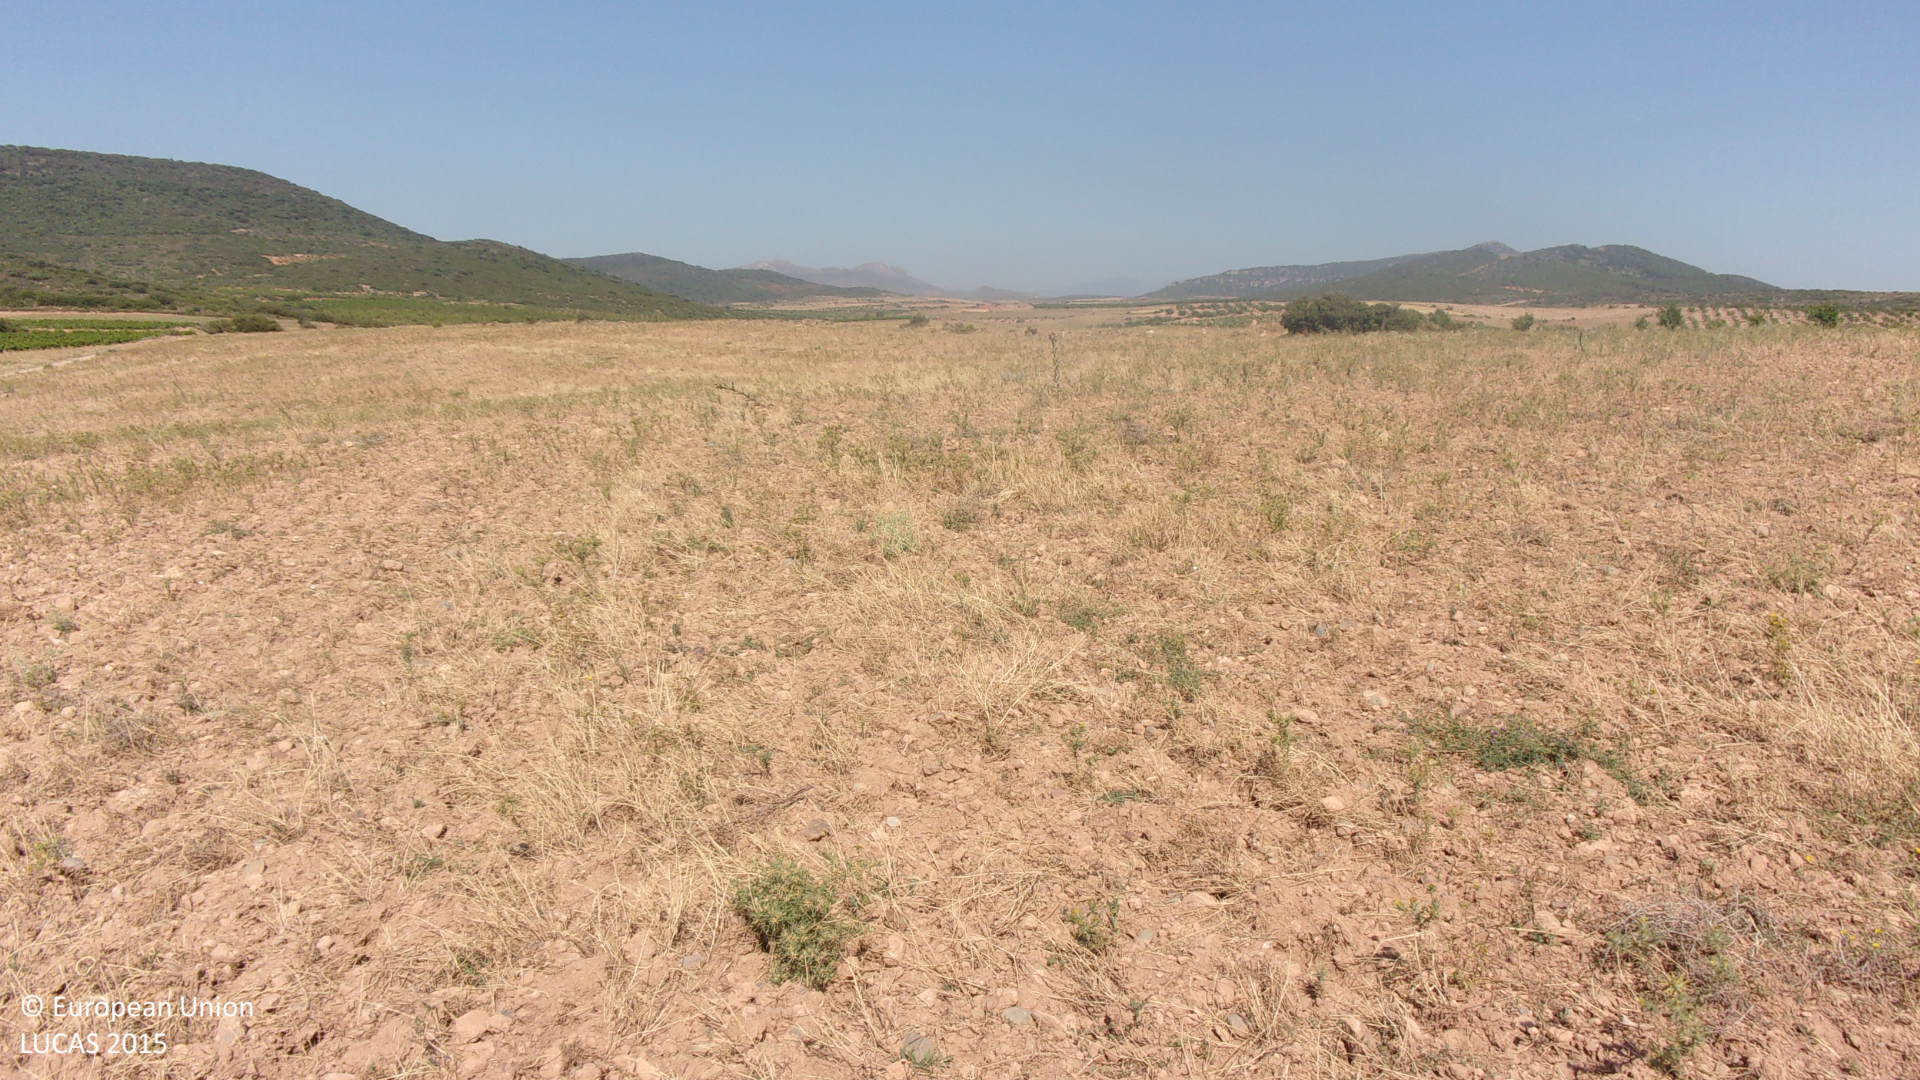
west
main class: Grassland
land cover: Spontaneously vegetated surfaces
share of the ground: 25 - 50 %
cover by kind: unconsolidated bare surface 65 %, herbaceous plants 35 %
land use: Fallow land
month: July
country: ES
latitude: 41.6744
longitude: -1.4499
